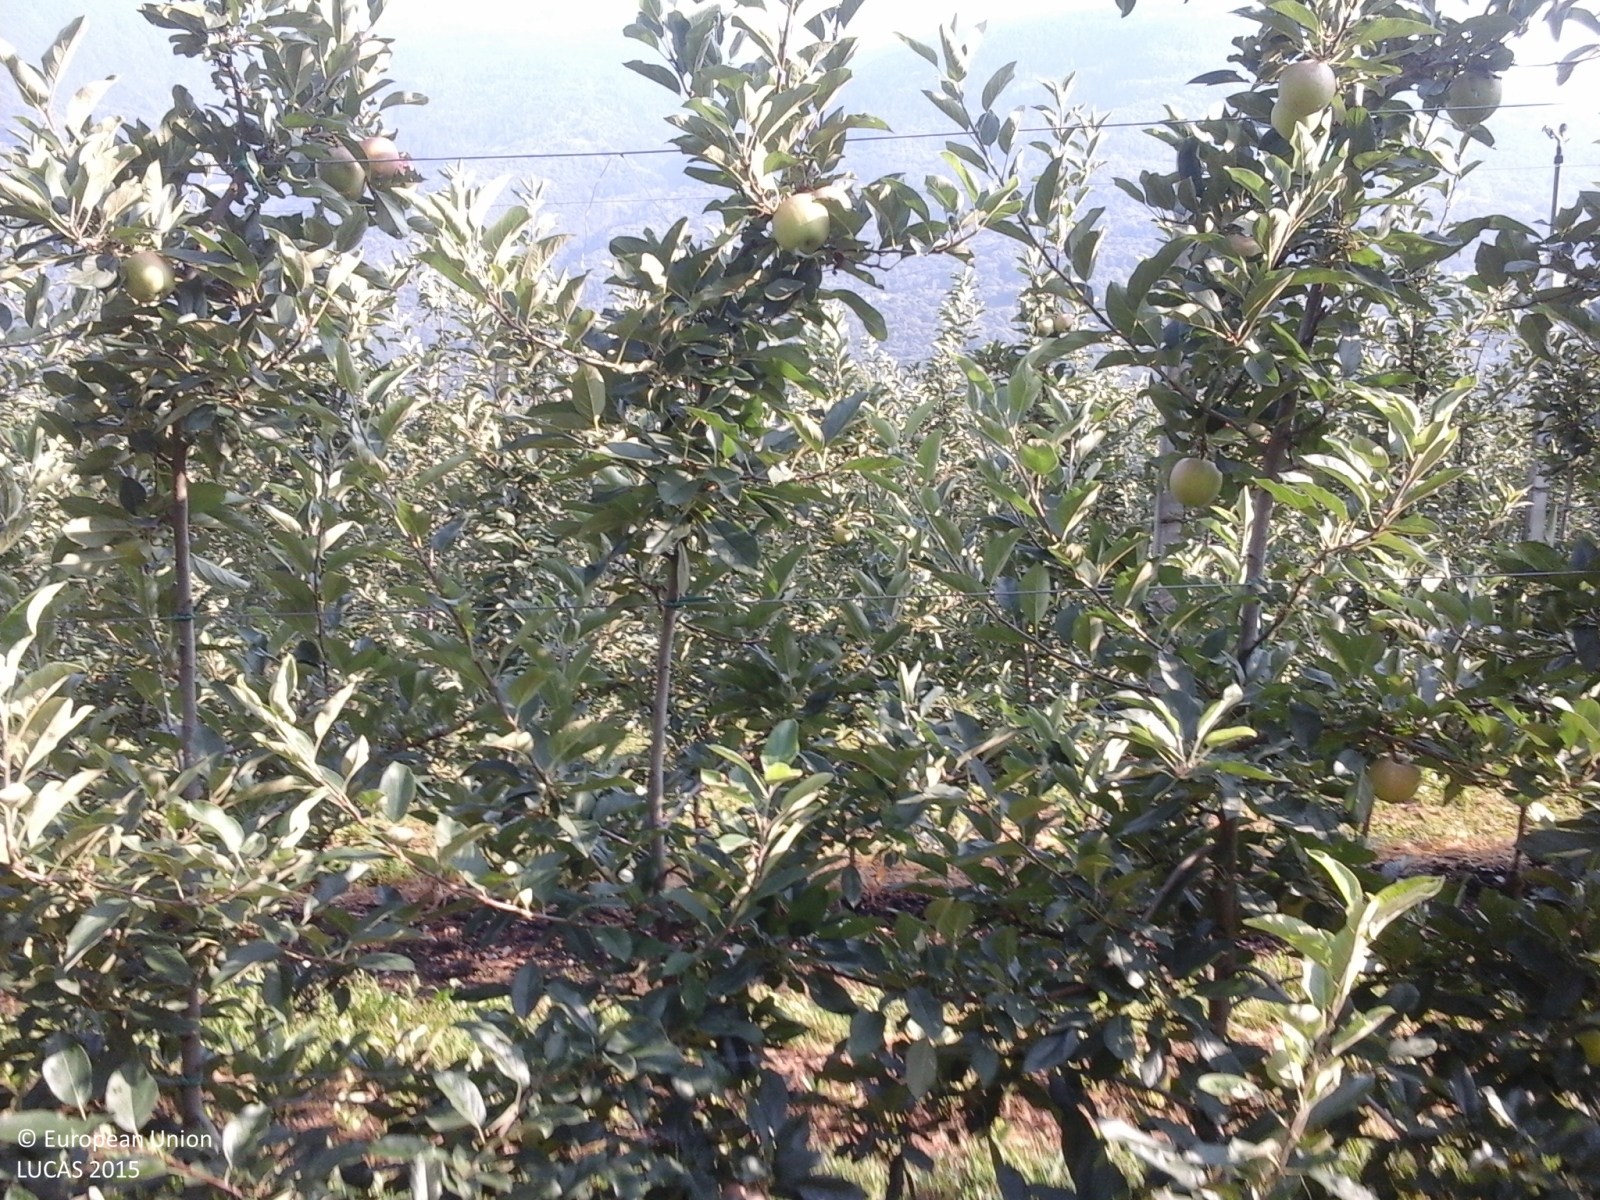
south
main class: Cropland
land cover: Apple fruit
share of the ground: > 75 %
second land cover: Grassland without tree/shrub cover
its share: > 75 %
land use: Agriculture (excluding fallow land and kitchen gardens)
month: July
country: IT
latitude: 46.1710
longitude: 9.9353
